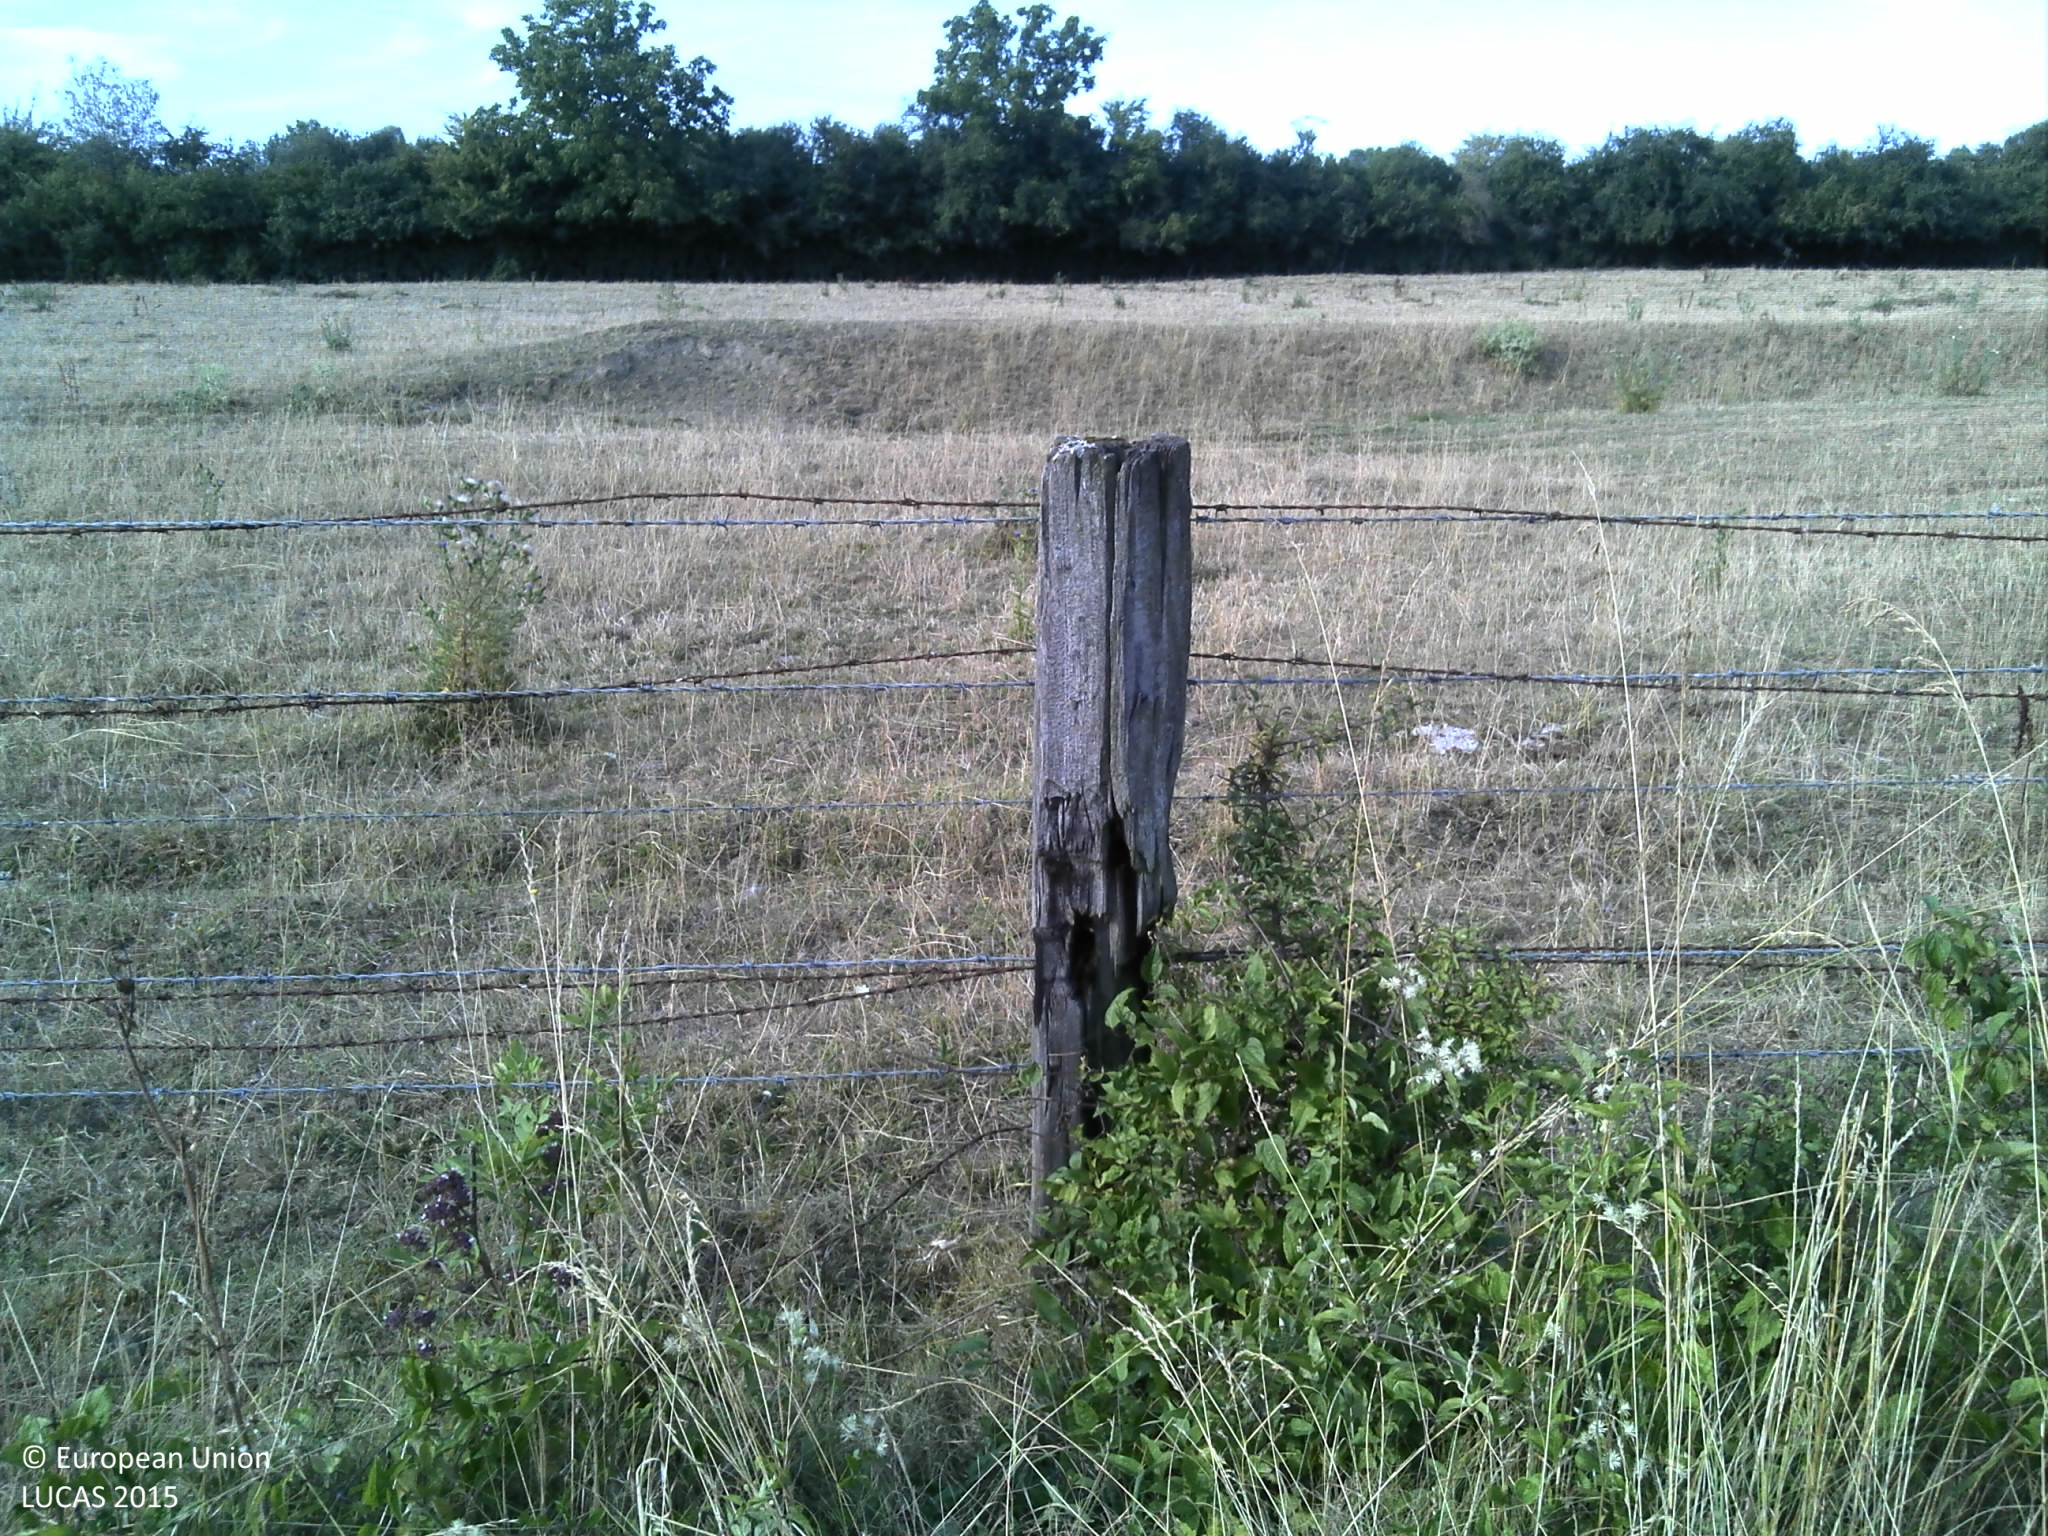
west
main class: Grassland
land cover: Grassland without tree/shrub cover
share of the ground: > 75 %
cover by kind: herbaceous plants 95 %, shrubs 5 %
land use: Agriculture (excluding fallow land and kitchen gardens)
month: August
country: FR
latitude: 49.0761
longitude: 4.8364
